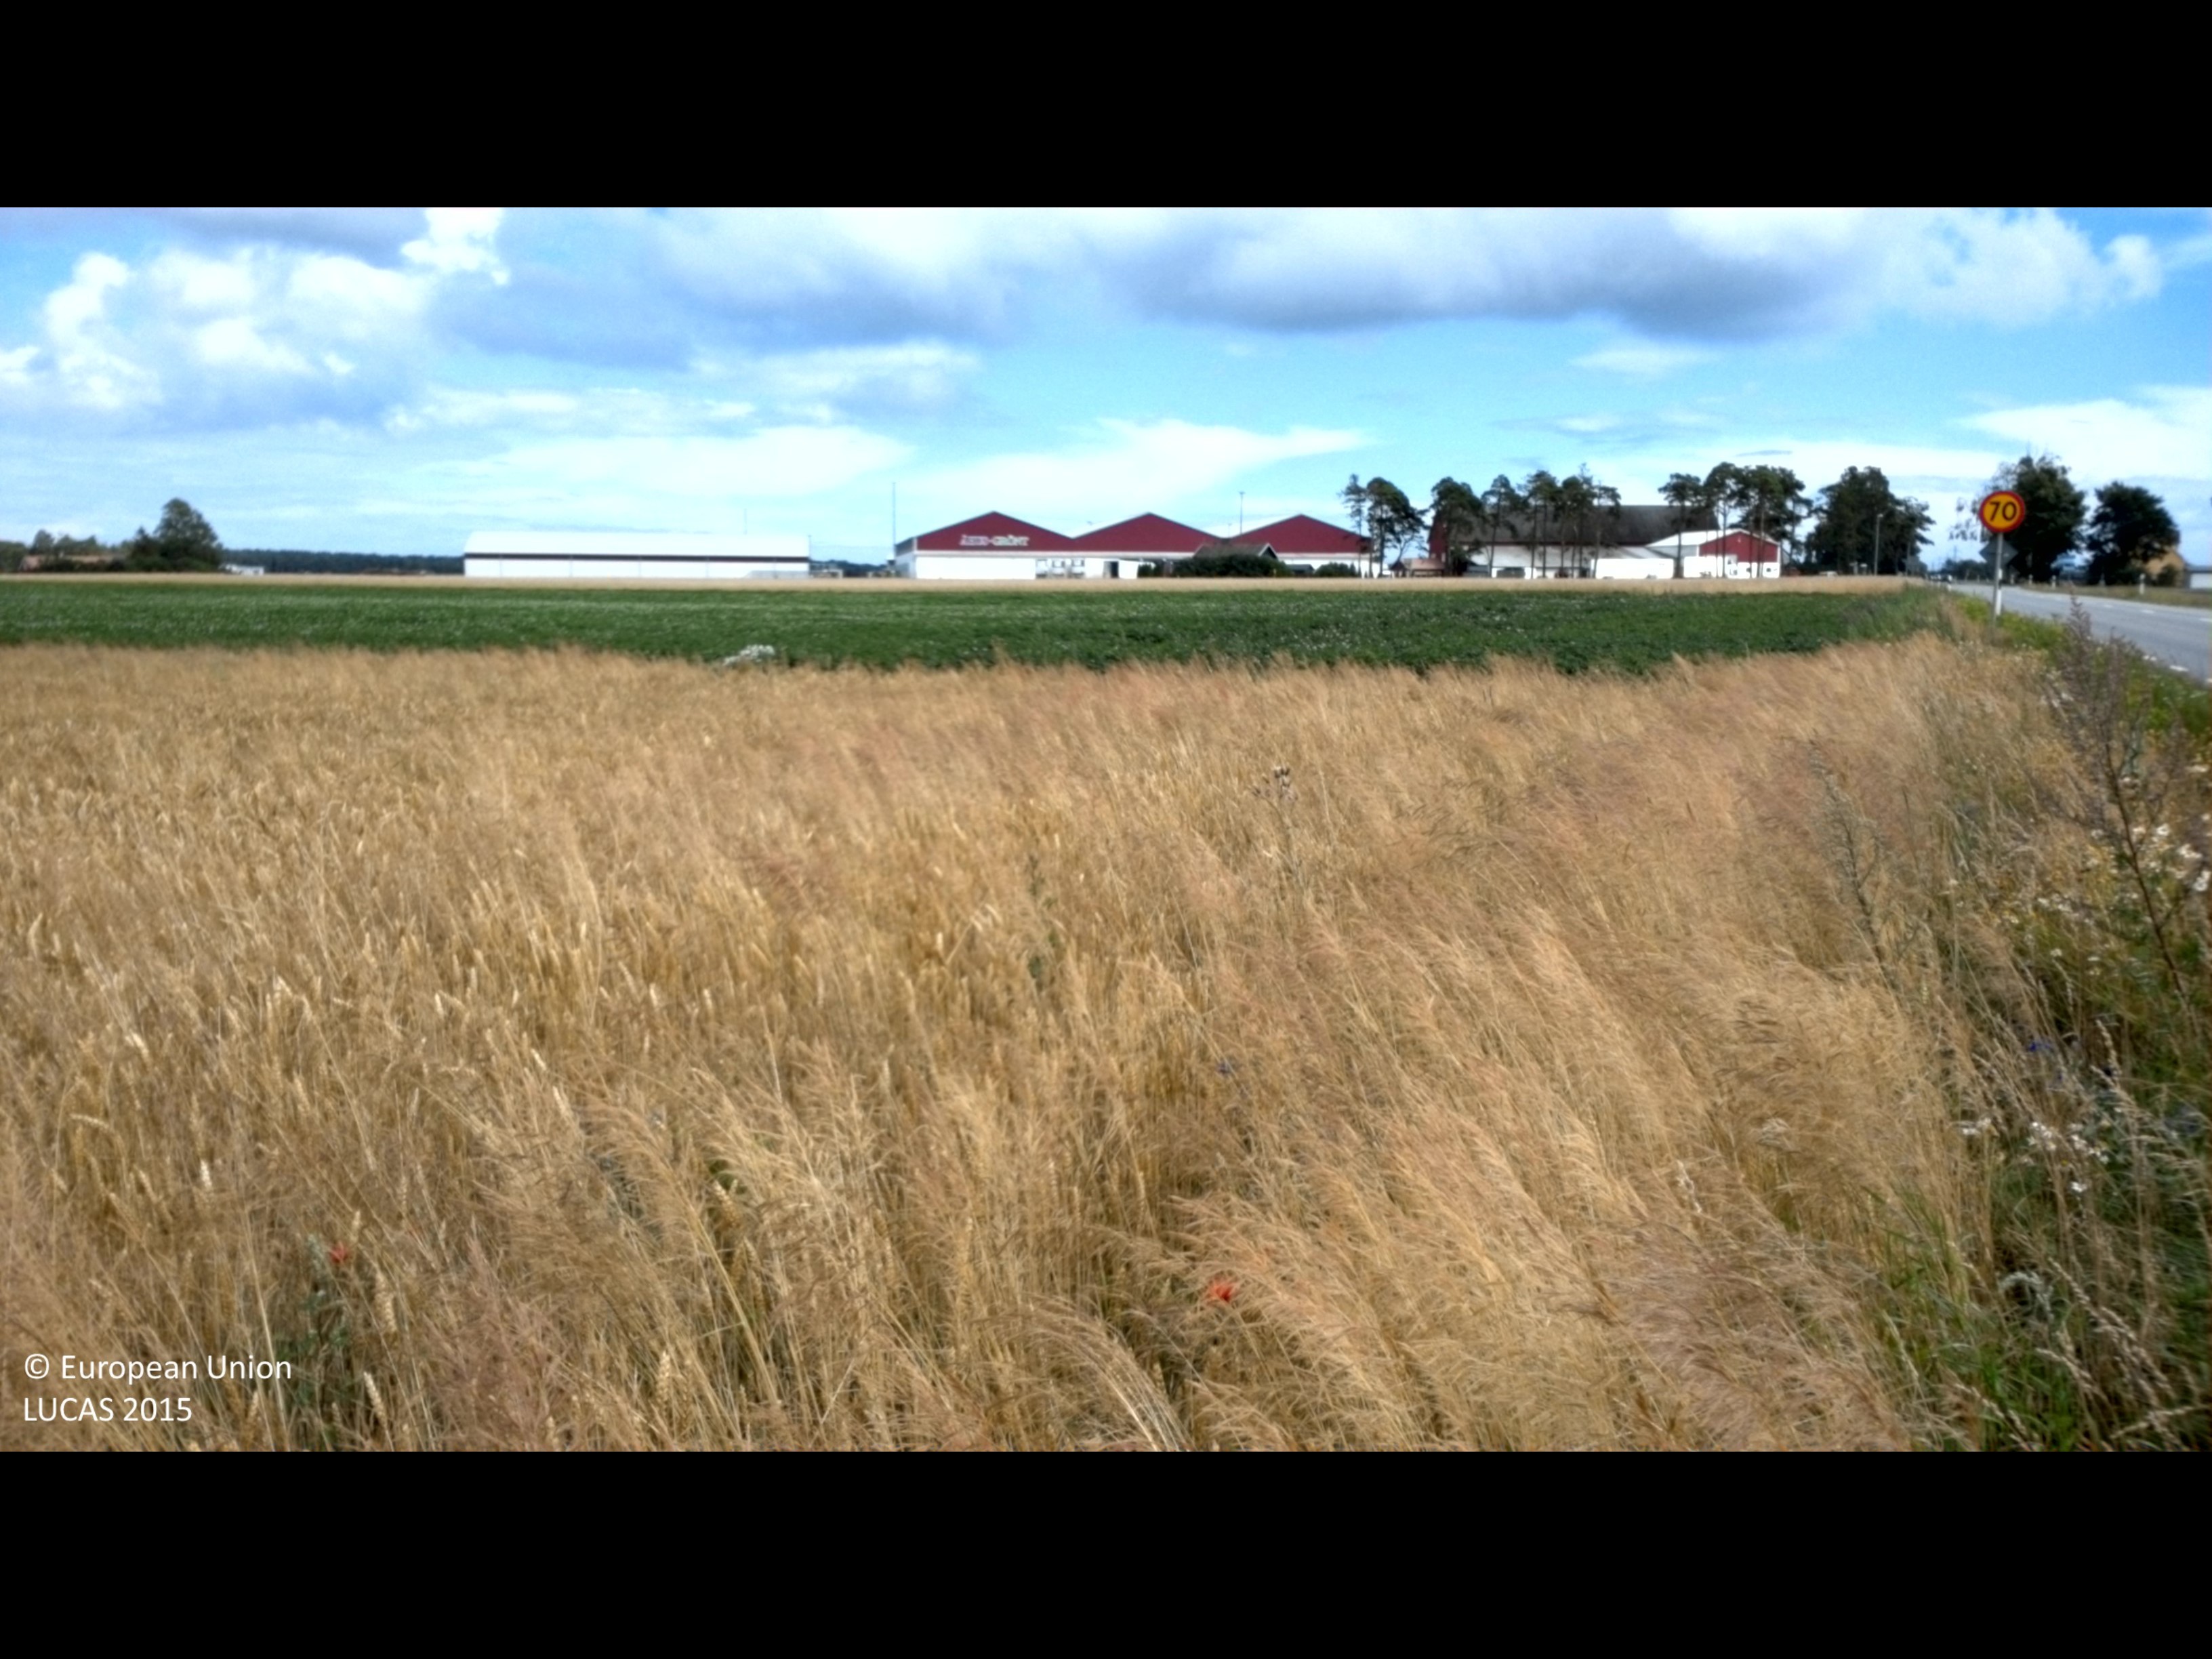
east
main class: Cropland
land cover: Common wheat
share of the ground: > 75 %
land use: Agriculture (excluding fallow land and kitchen gardens)
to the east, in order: Common wheat; Potatoes; Barley
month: July
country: SE
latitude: 55.9377
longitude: 14.2405
